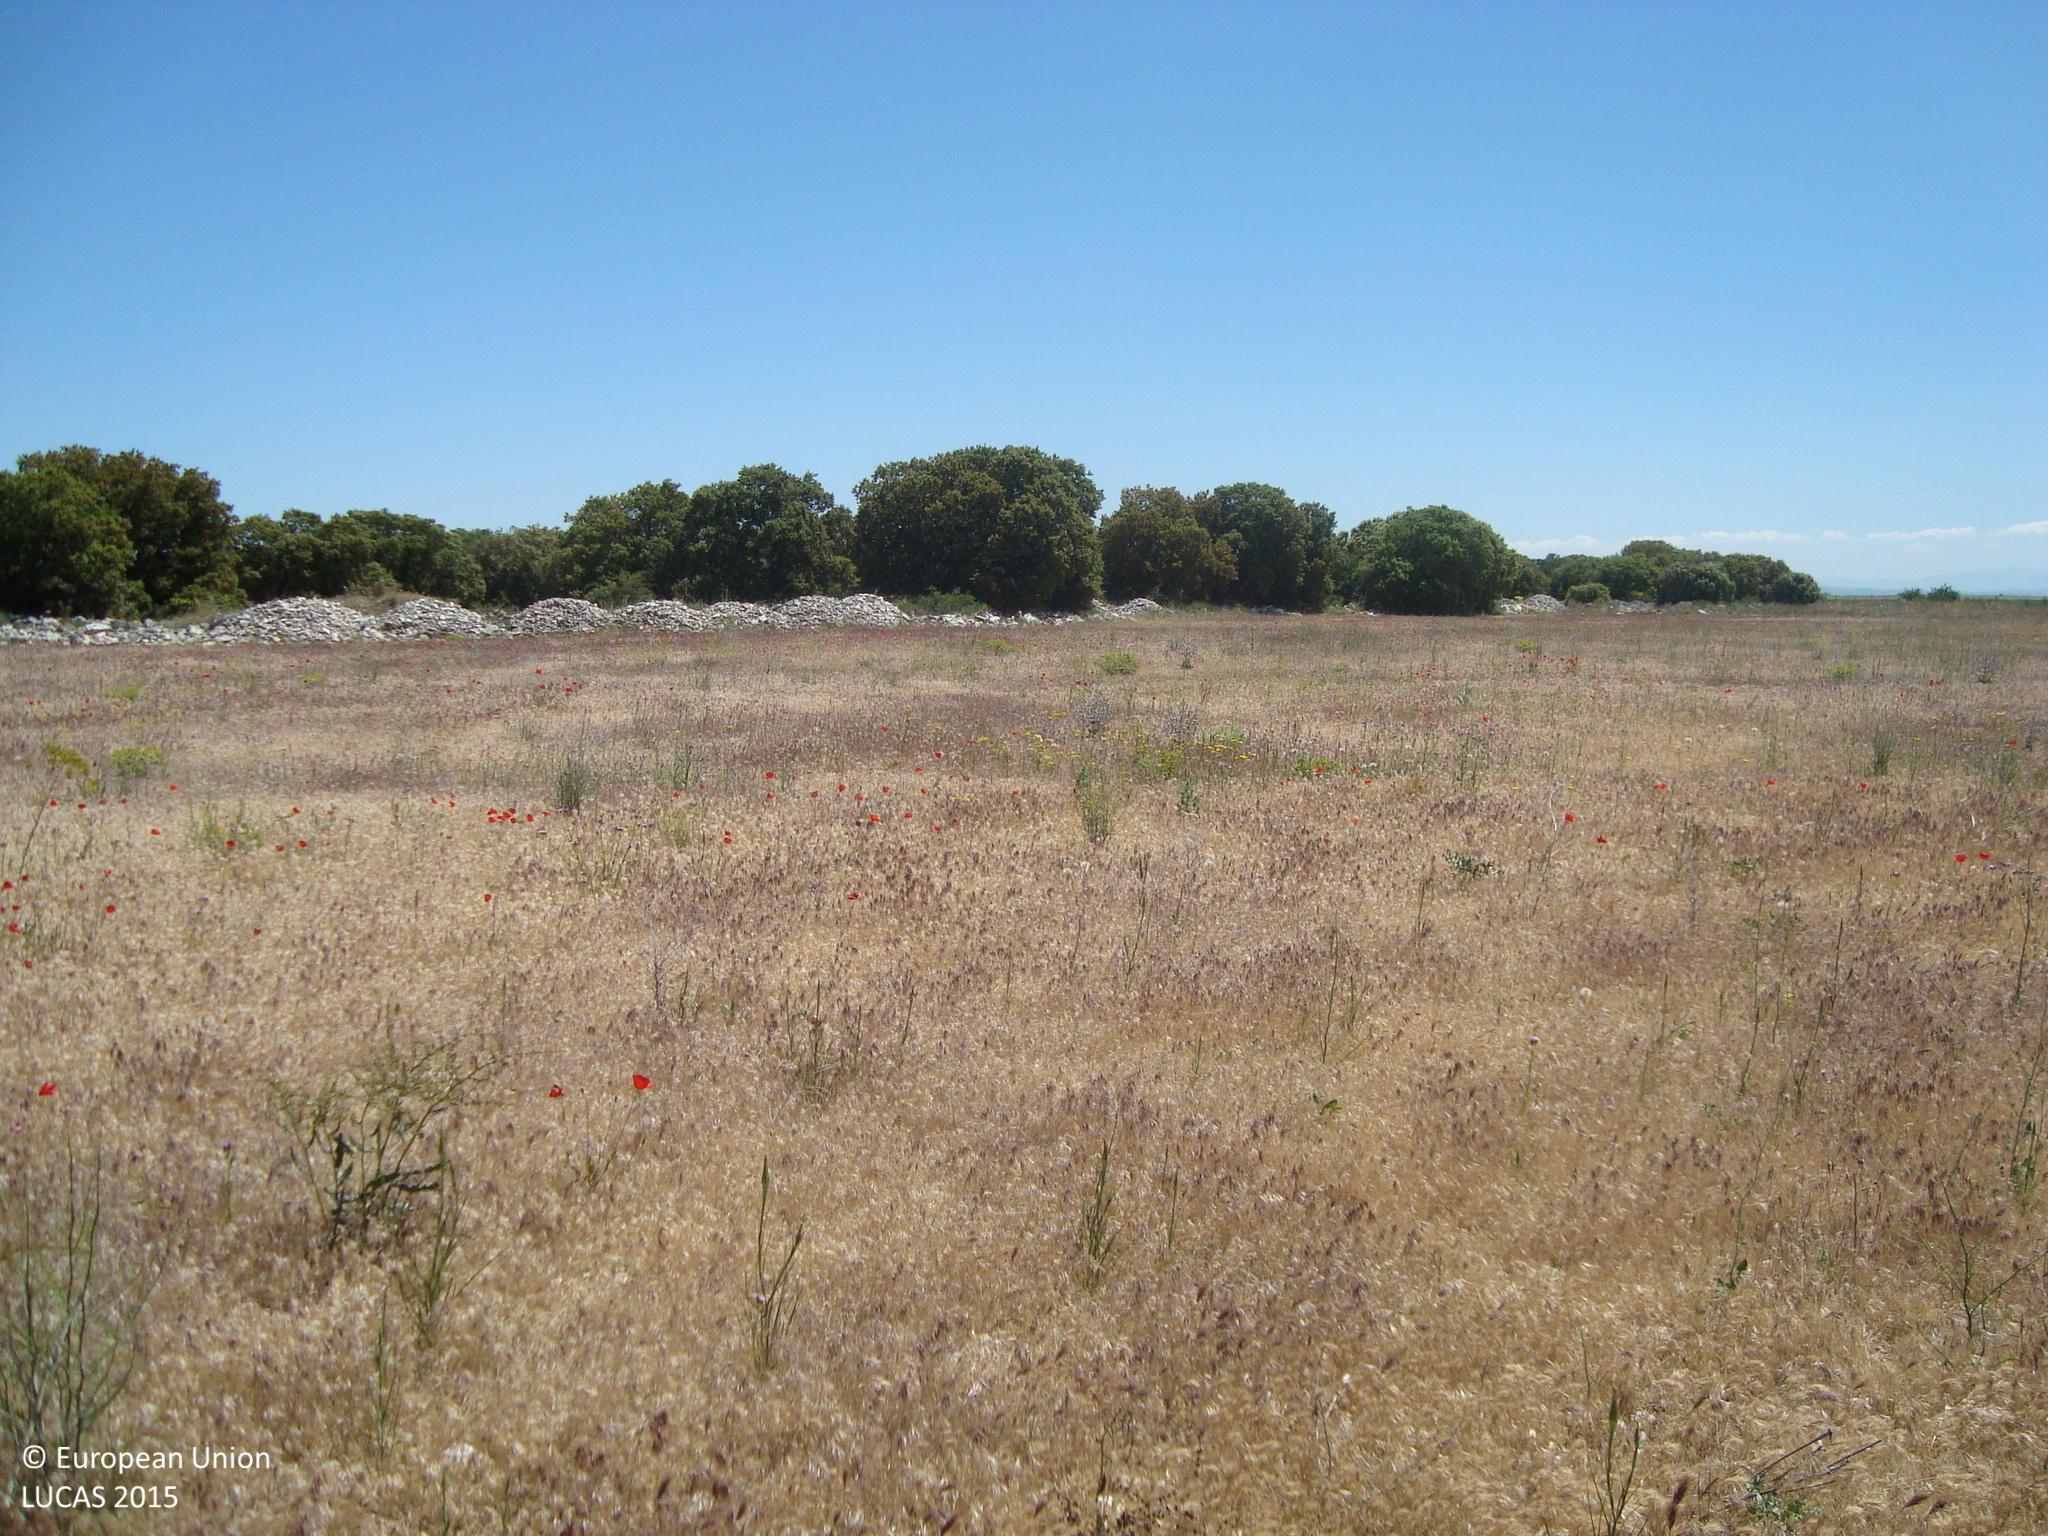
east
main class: Grassland
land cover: Spontaneously vegetated surfaces
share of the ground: > 75 %
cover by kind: herbaceous plants 90 %, unconsolidated bare surface 10 %
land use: Abandoned areas
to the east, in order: Spontaneously vegetated surfaces; Dry stone walls; Broadleaved woodland; Rock outcrops; Broadleaved woodland; Spontaneously vegetated surfaces
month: May
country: ES
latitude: 41.5392
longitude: -4.1911
